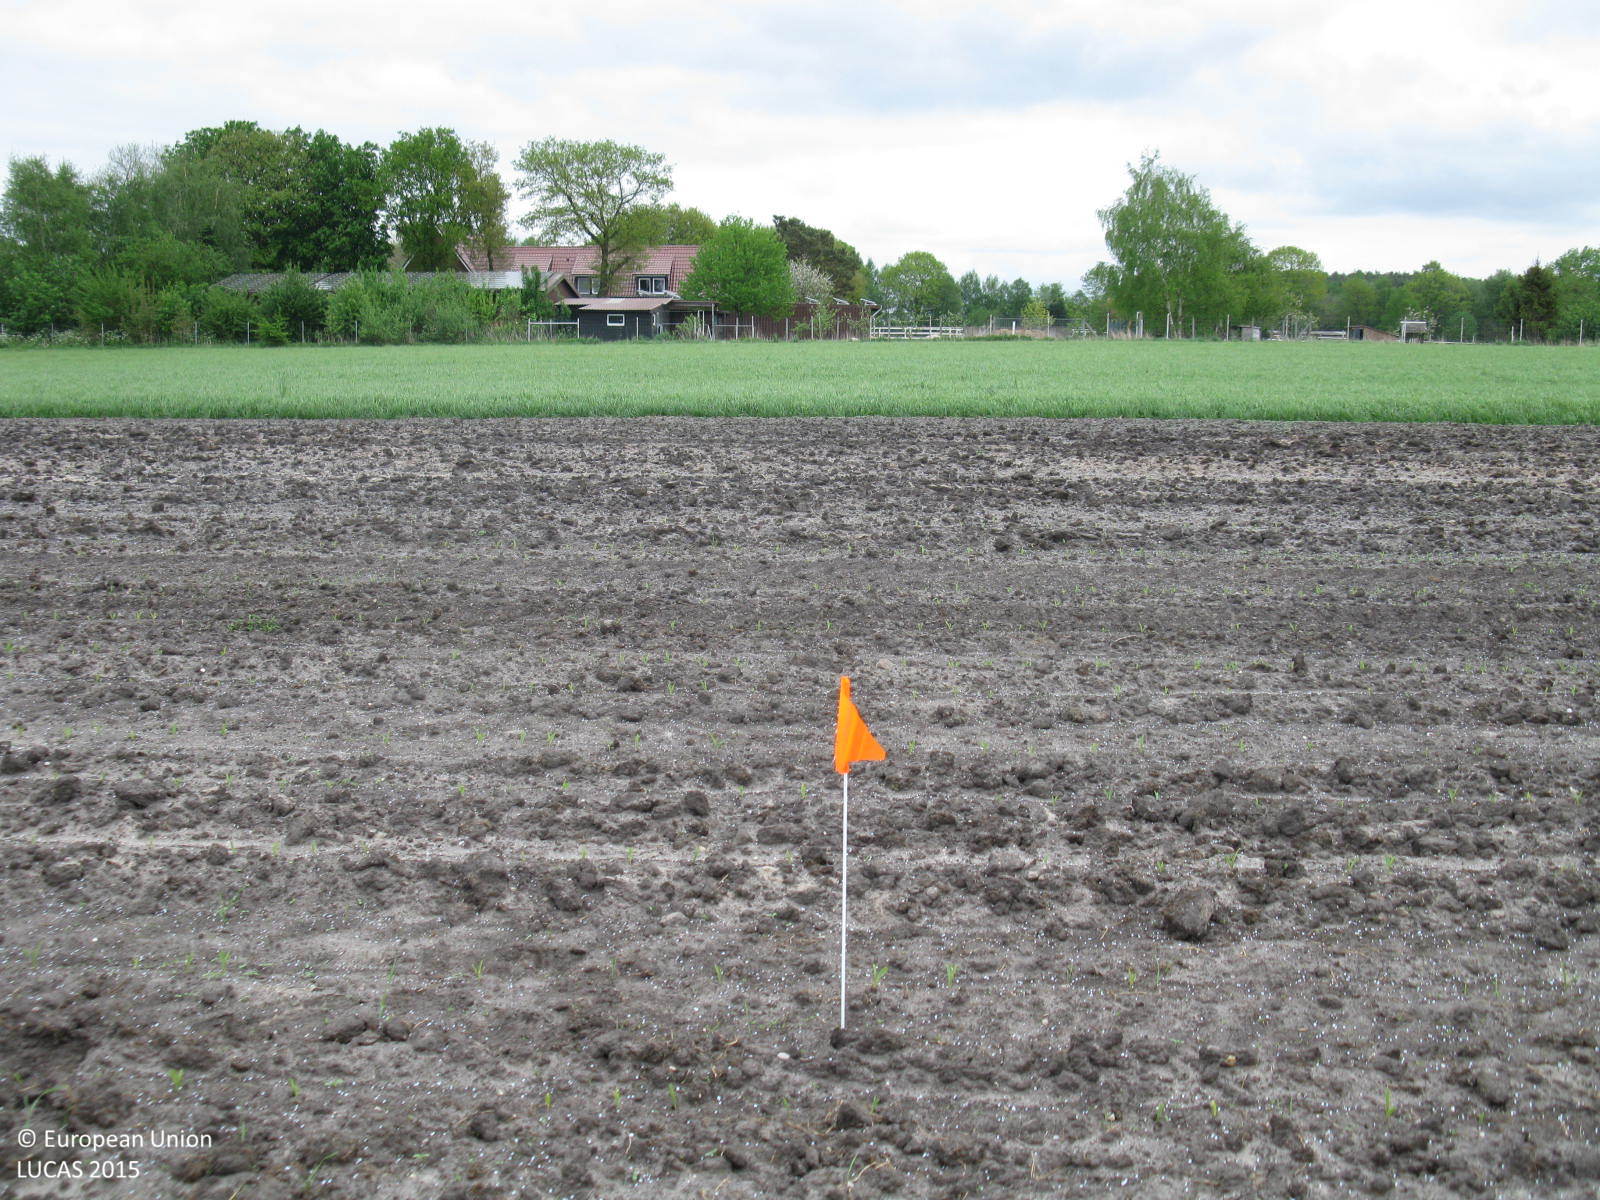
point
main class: Cropland
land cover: Maize
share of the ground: < 10 %
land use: Agriculture (excluding fallow land and kitchen gardens)
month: May
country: DE
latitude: 52.8520
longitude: 7.3720
